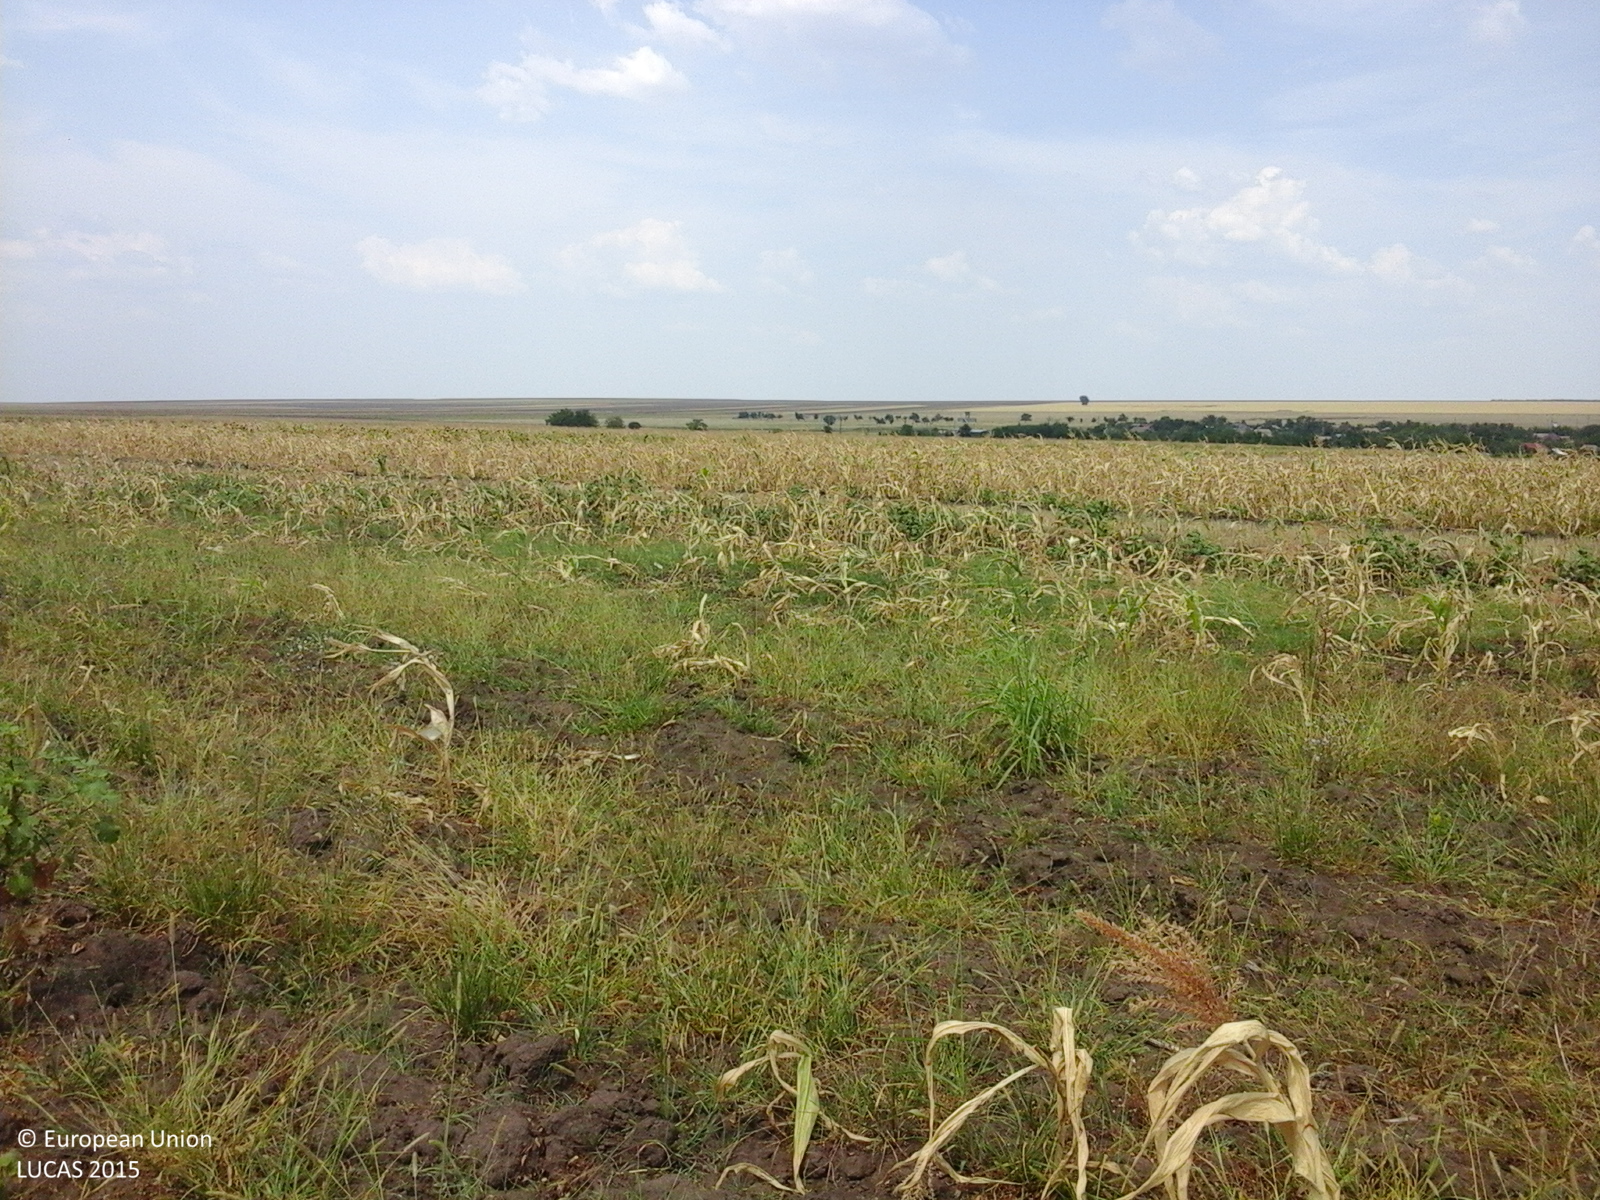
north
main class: Cropland
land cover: Maize
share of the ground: 10 - 25 %
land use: Agriculture (excluding fallow land and kitchen gardens)
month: August
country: RO
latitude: 44.2245
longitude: 23.1267
